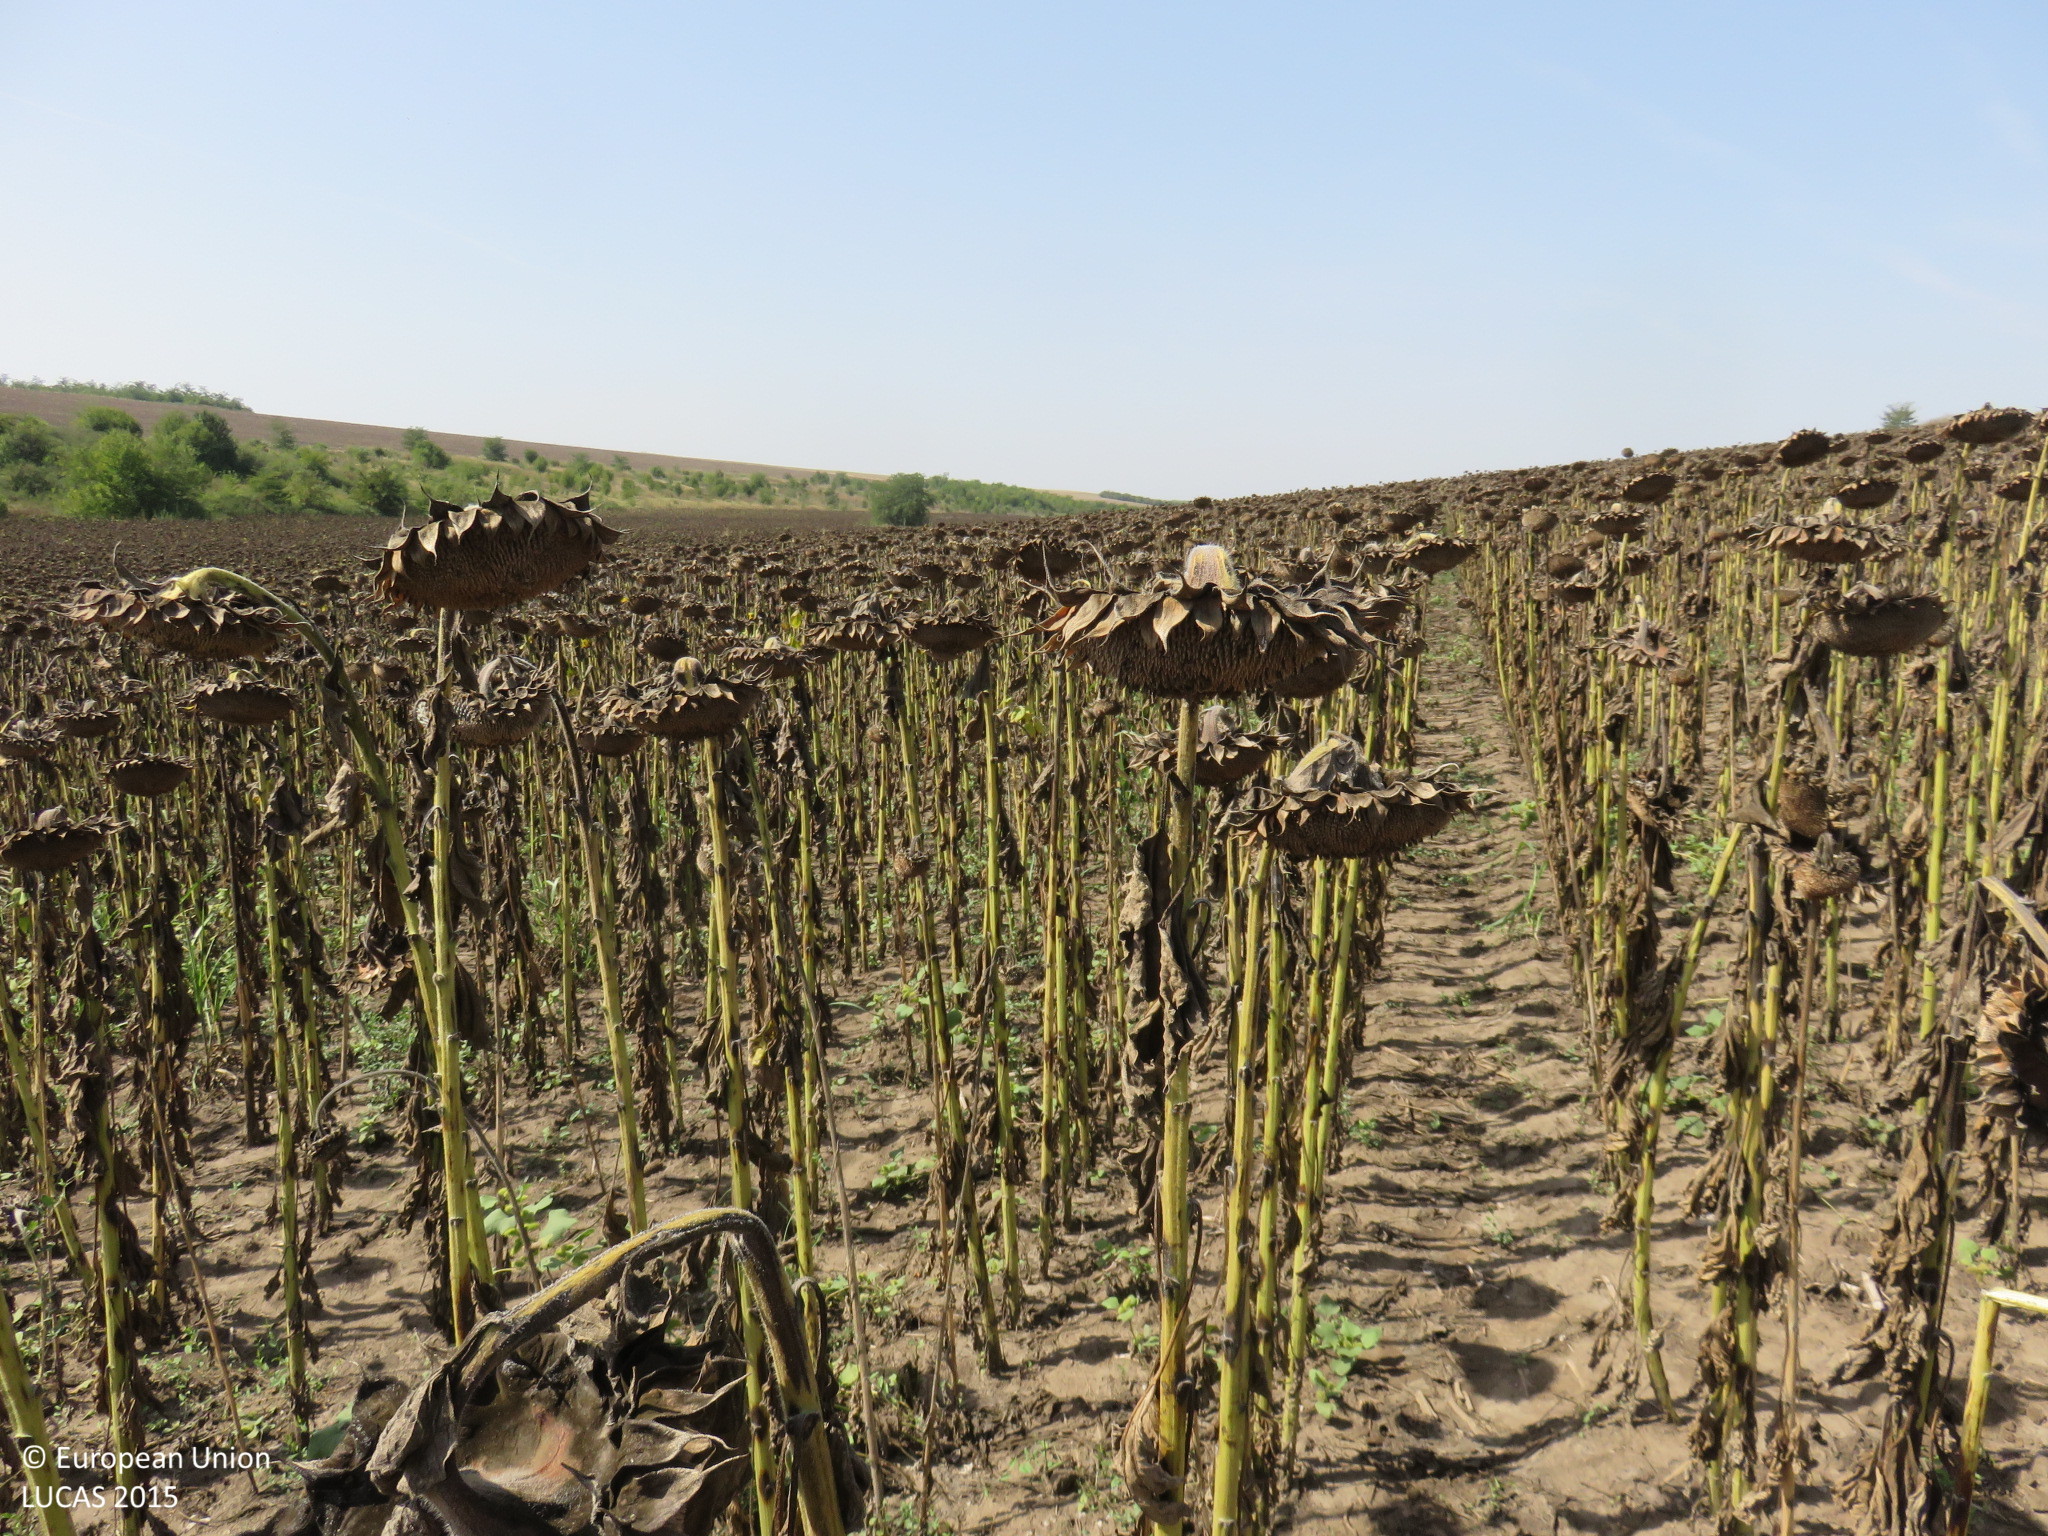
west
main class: Cropland
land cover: Sunflower
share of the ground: > 75 %
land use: Agriculture (excluding fallow land and kitchen gardens)
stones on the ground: < 10 %
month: September
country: BG
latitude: 43.5588
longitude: 24.5345
